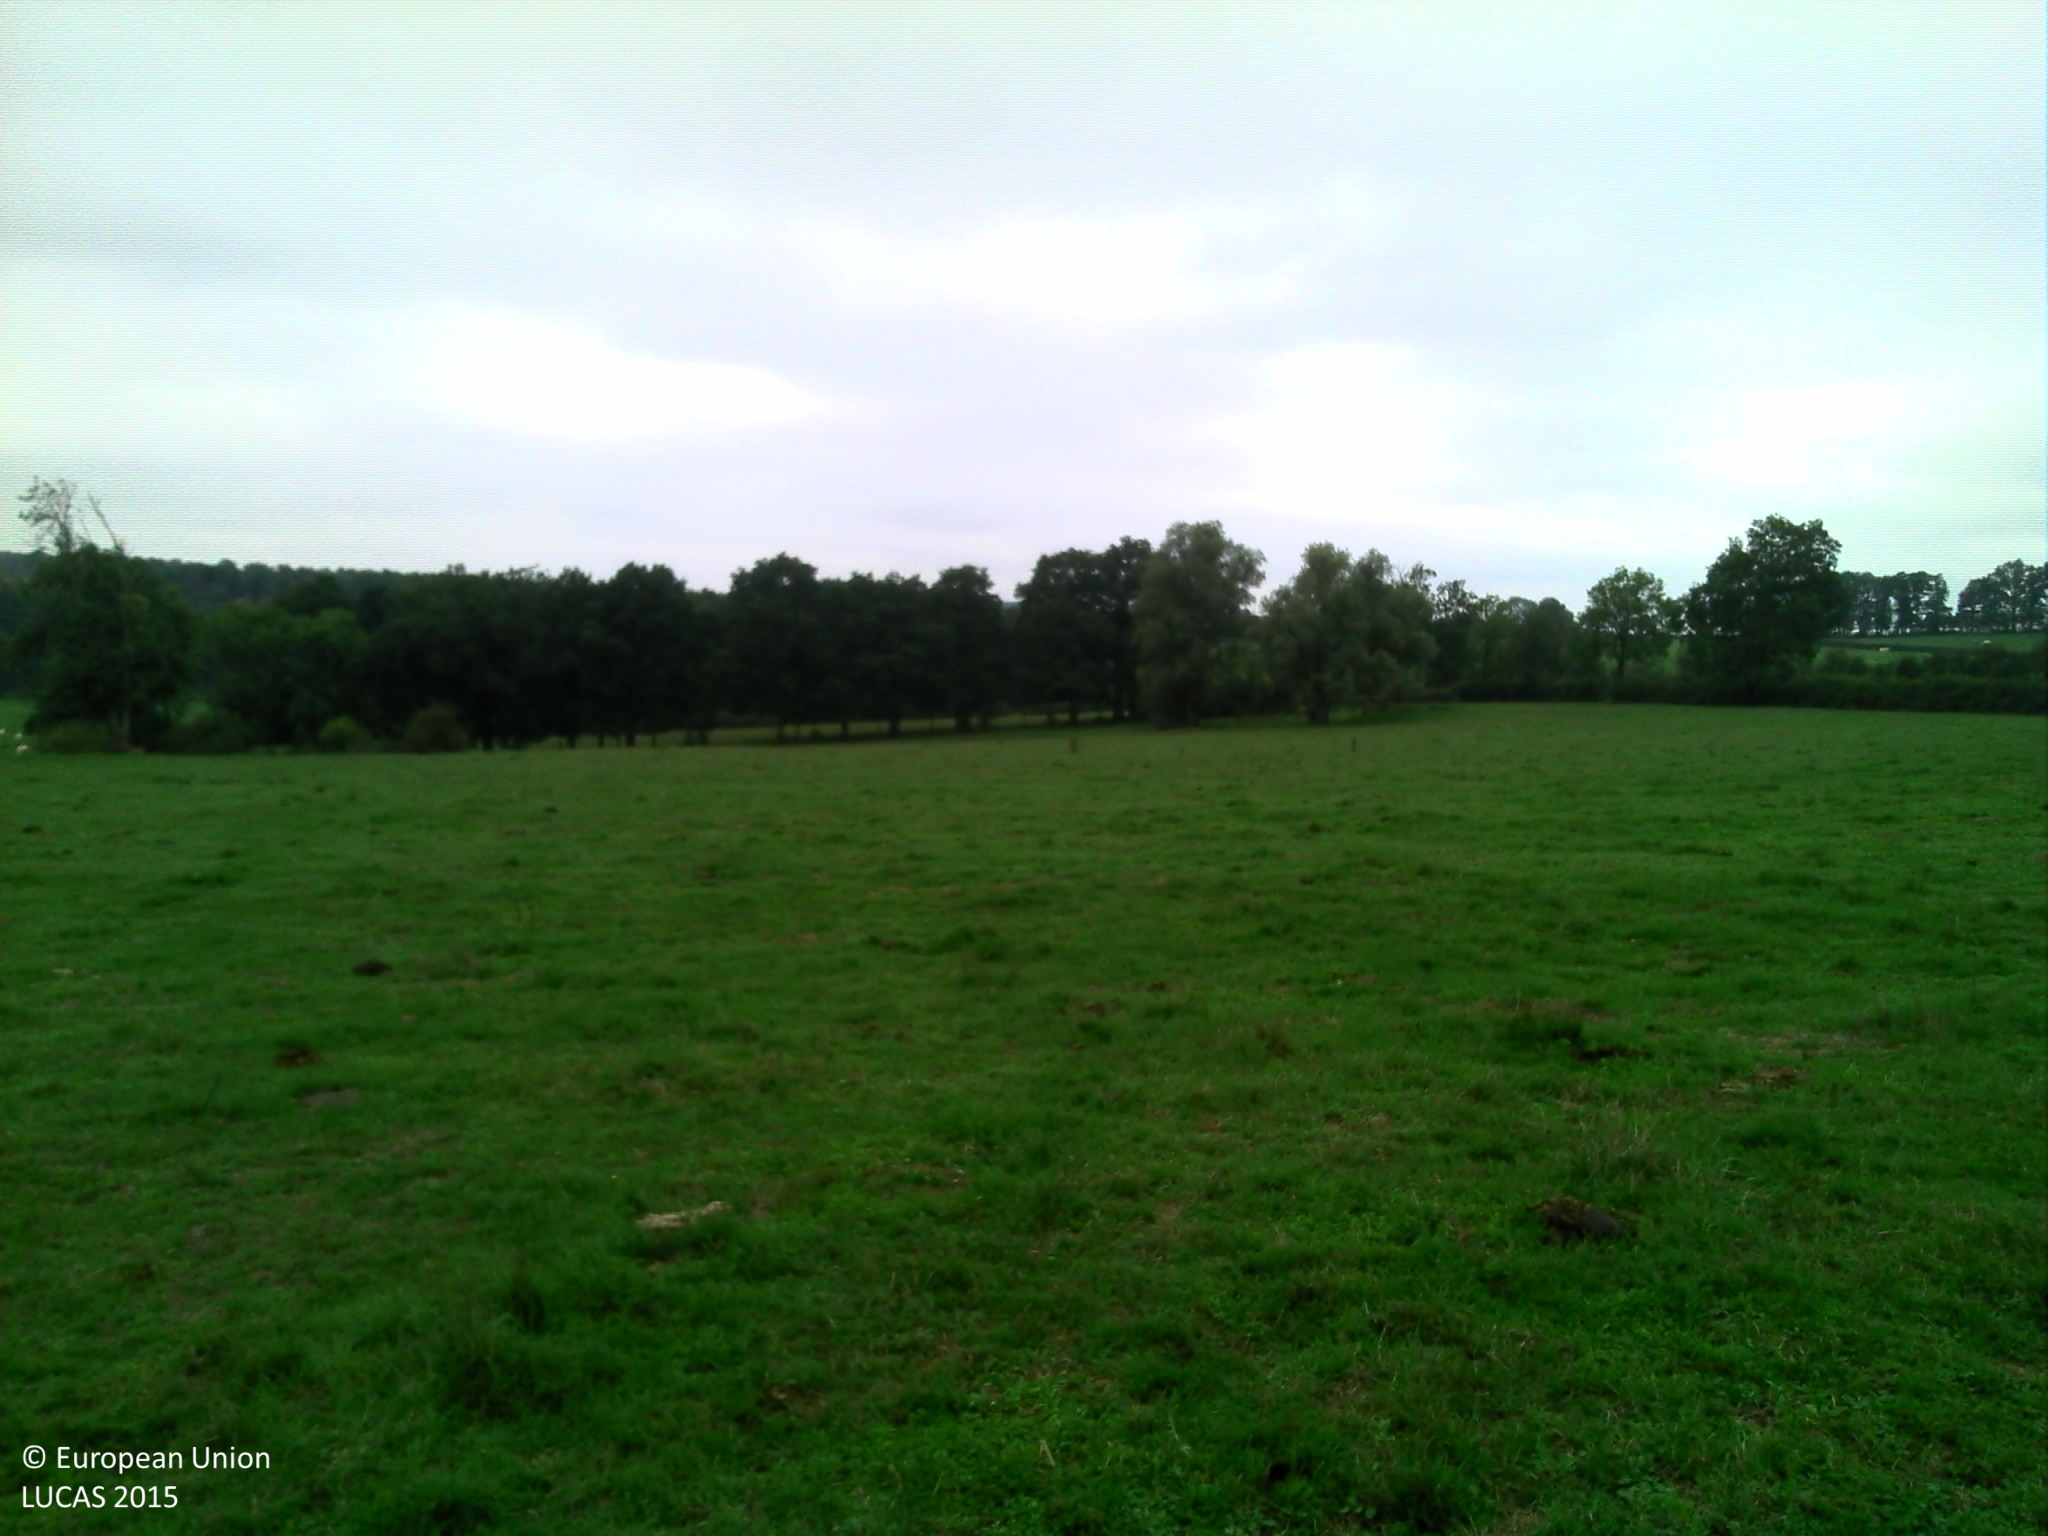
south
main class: Grassland
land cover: Grassland without tree/shrub cover
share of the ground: > 75 %
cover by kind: herbaceous plants 100 %
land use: Agriculture (excluding fallow land and kitchen gardens)
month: September
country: FR
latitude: 47.1649
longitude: 4.4724
